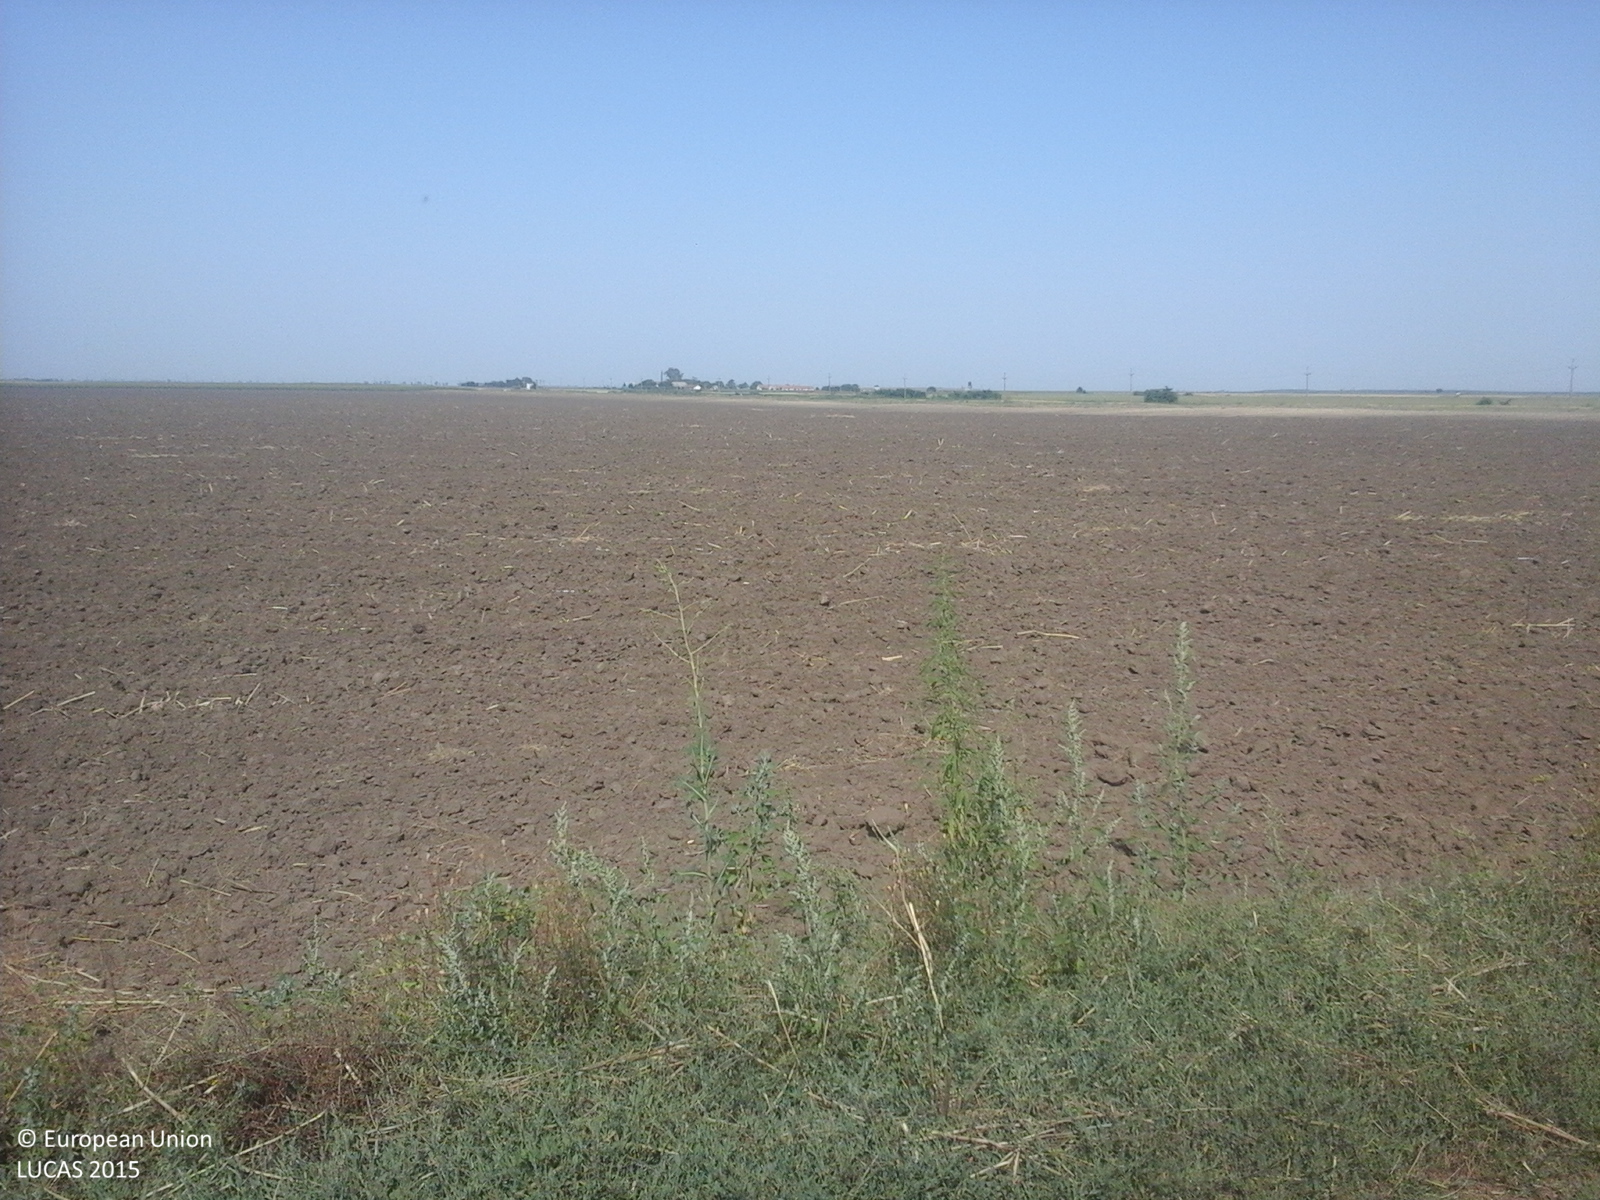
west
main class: Cropland
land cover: Maize
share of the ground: > 75 %
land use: Agriculture (excluding fallow land and kitchen gardens)
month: July
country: RO
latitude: 44.8276
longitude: 27.5648
